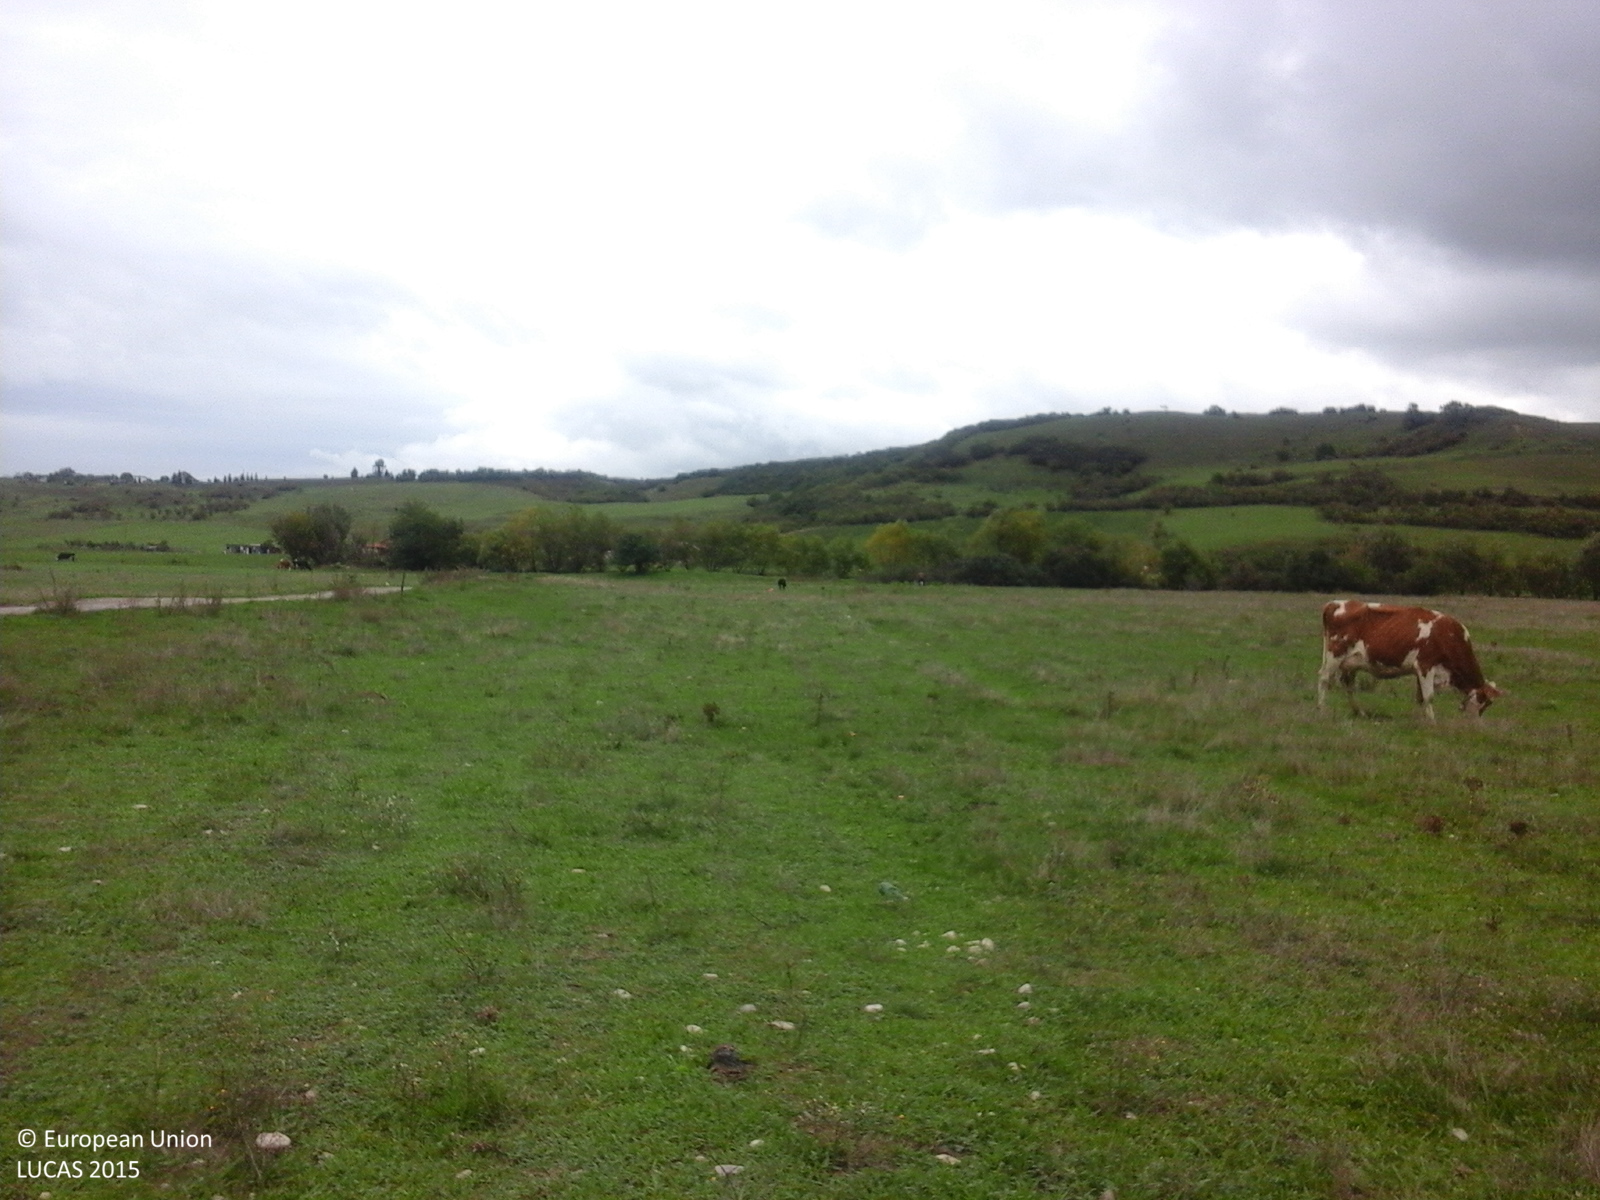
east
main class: Grassland
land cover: Grassland without tree/shrub cover
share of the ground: > 75 %
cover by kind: herbaceous plants 100 %
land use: Agriculture (excluding fallow land and kitchen gardens)
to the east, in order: Grassland without tree/shrub cover; Single bushes/trees; Grassland without tree/shrub cover; Ditches and canals; Fences; Lines of trees; Grassland without tree/shrub cover
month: September
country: RO
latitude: 45.9380
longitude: 23.5695
